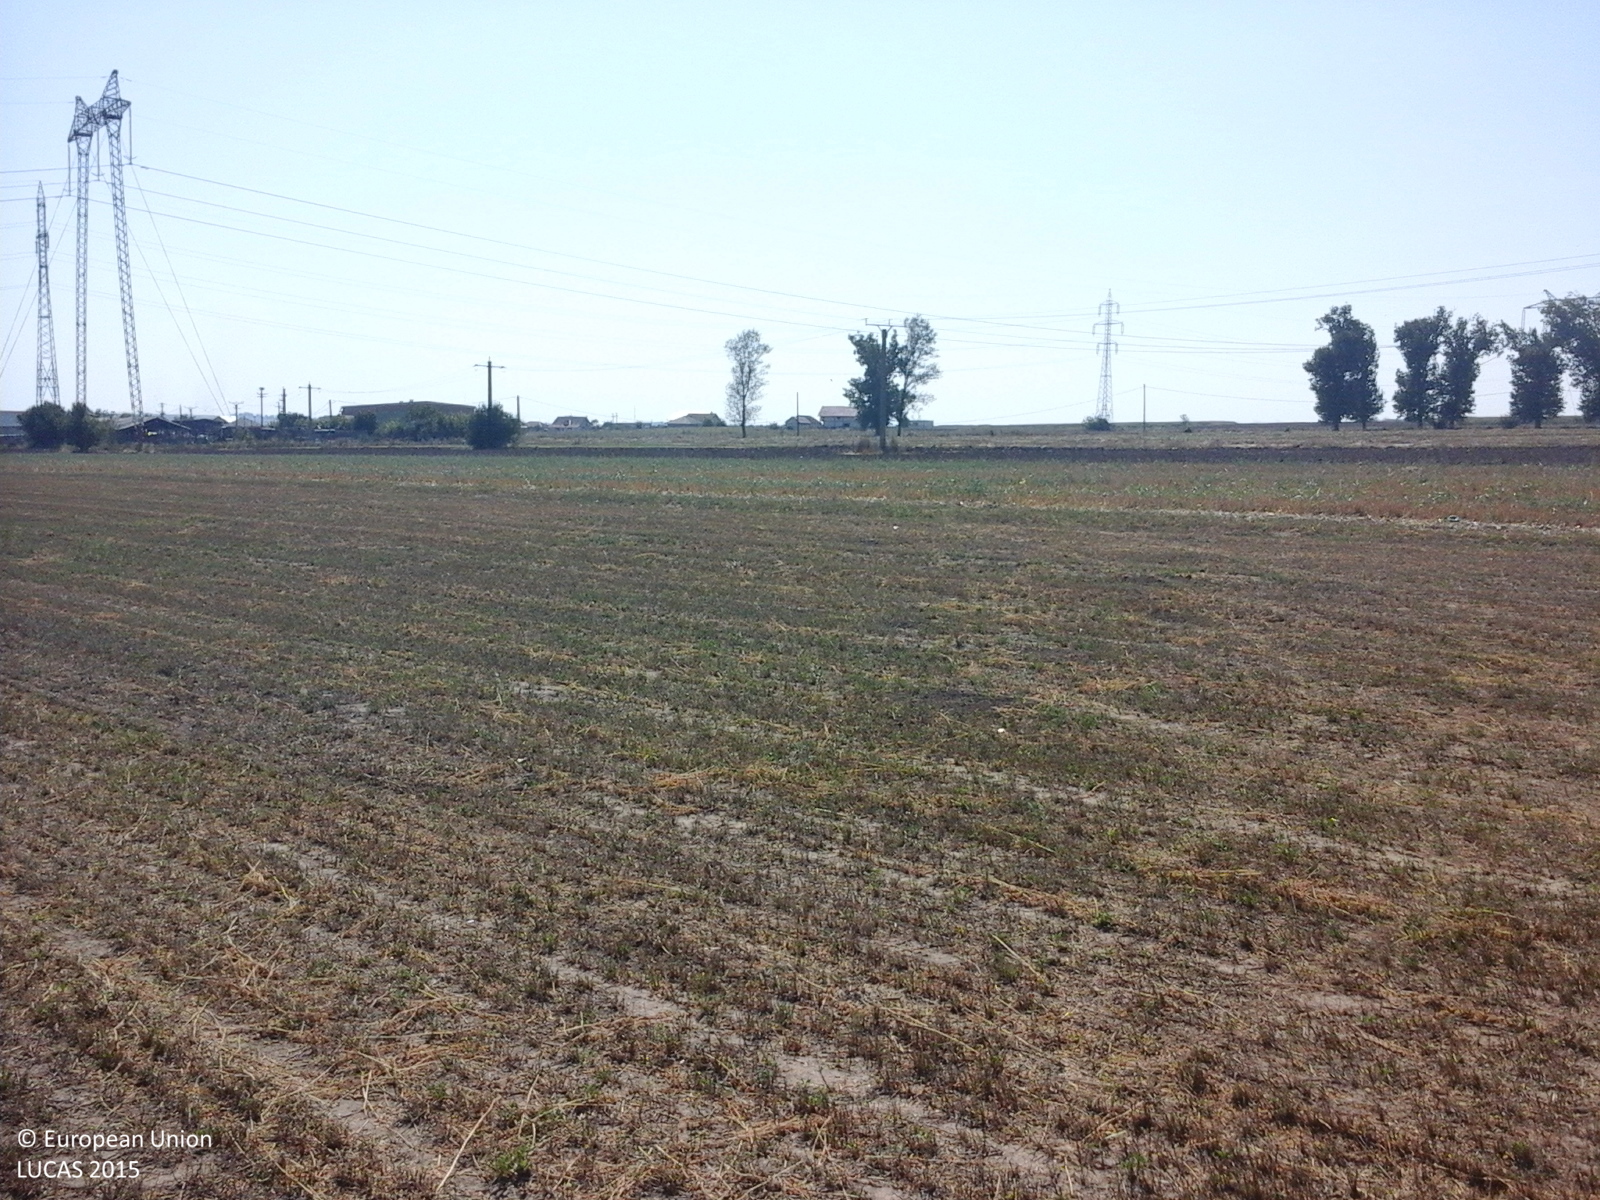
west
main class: Cropland
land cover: Lucerne
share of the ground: 10 - 25 %
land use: Agriculture (excluding fallow land and kitchen gardens)
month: August
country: RO
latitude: 44.2673
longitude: 28.3429
